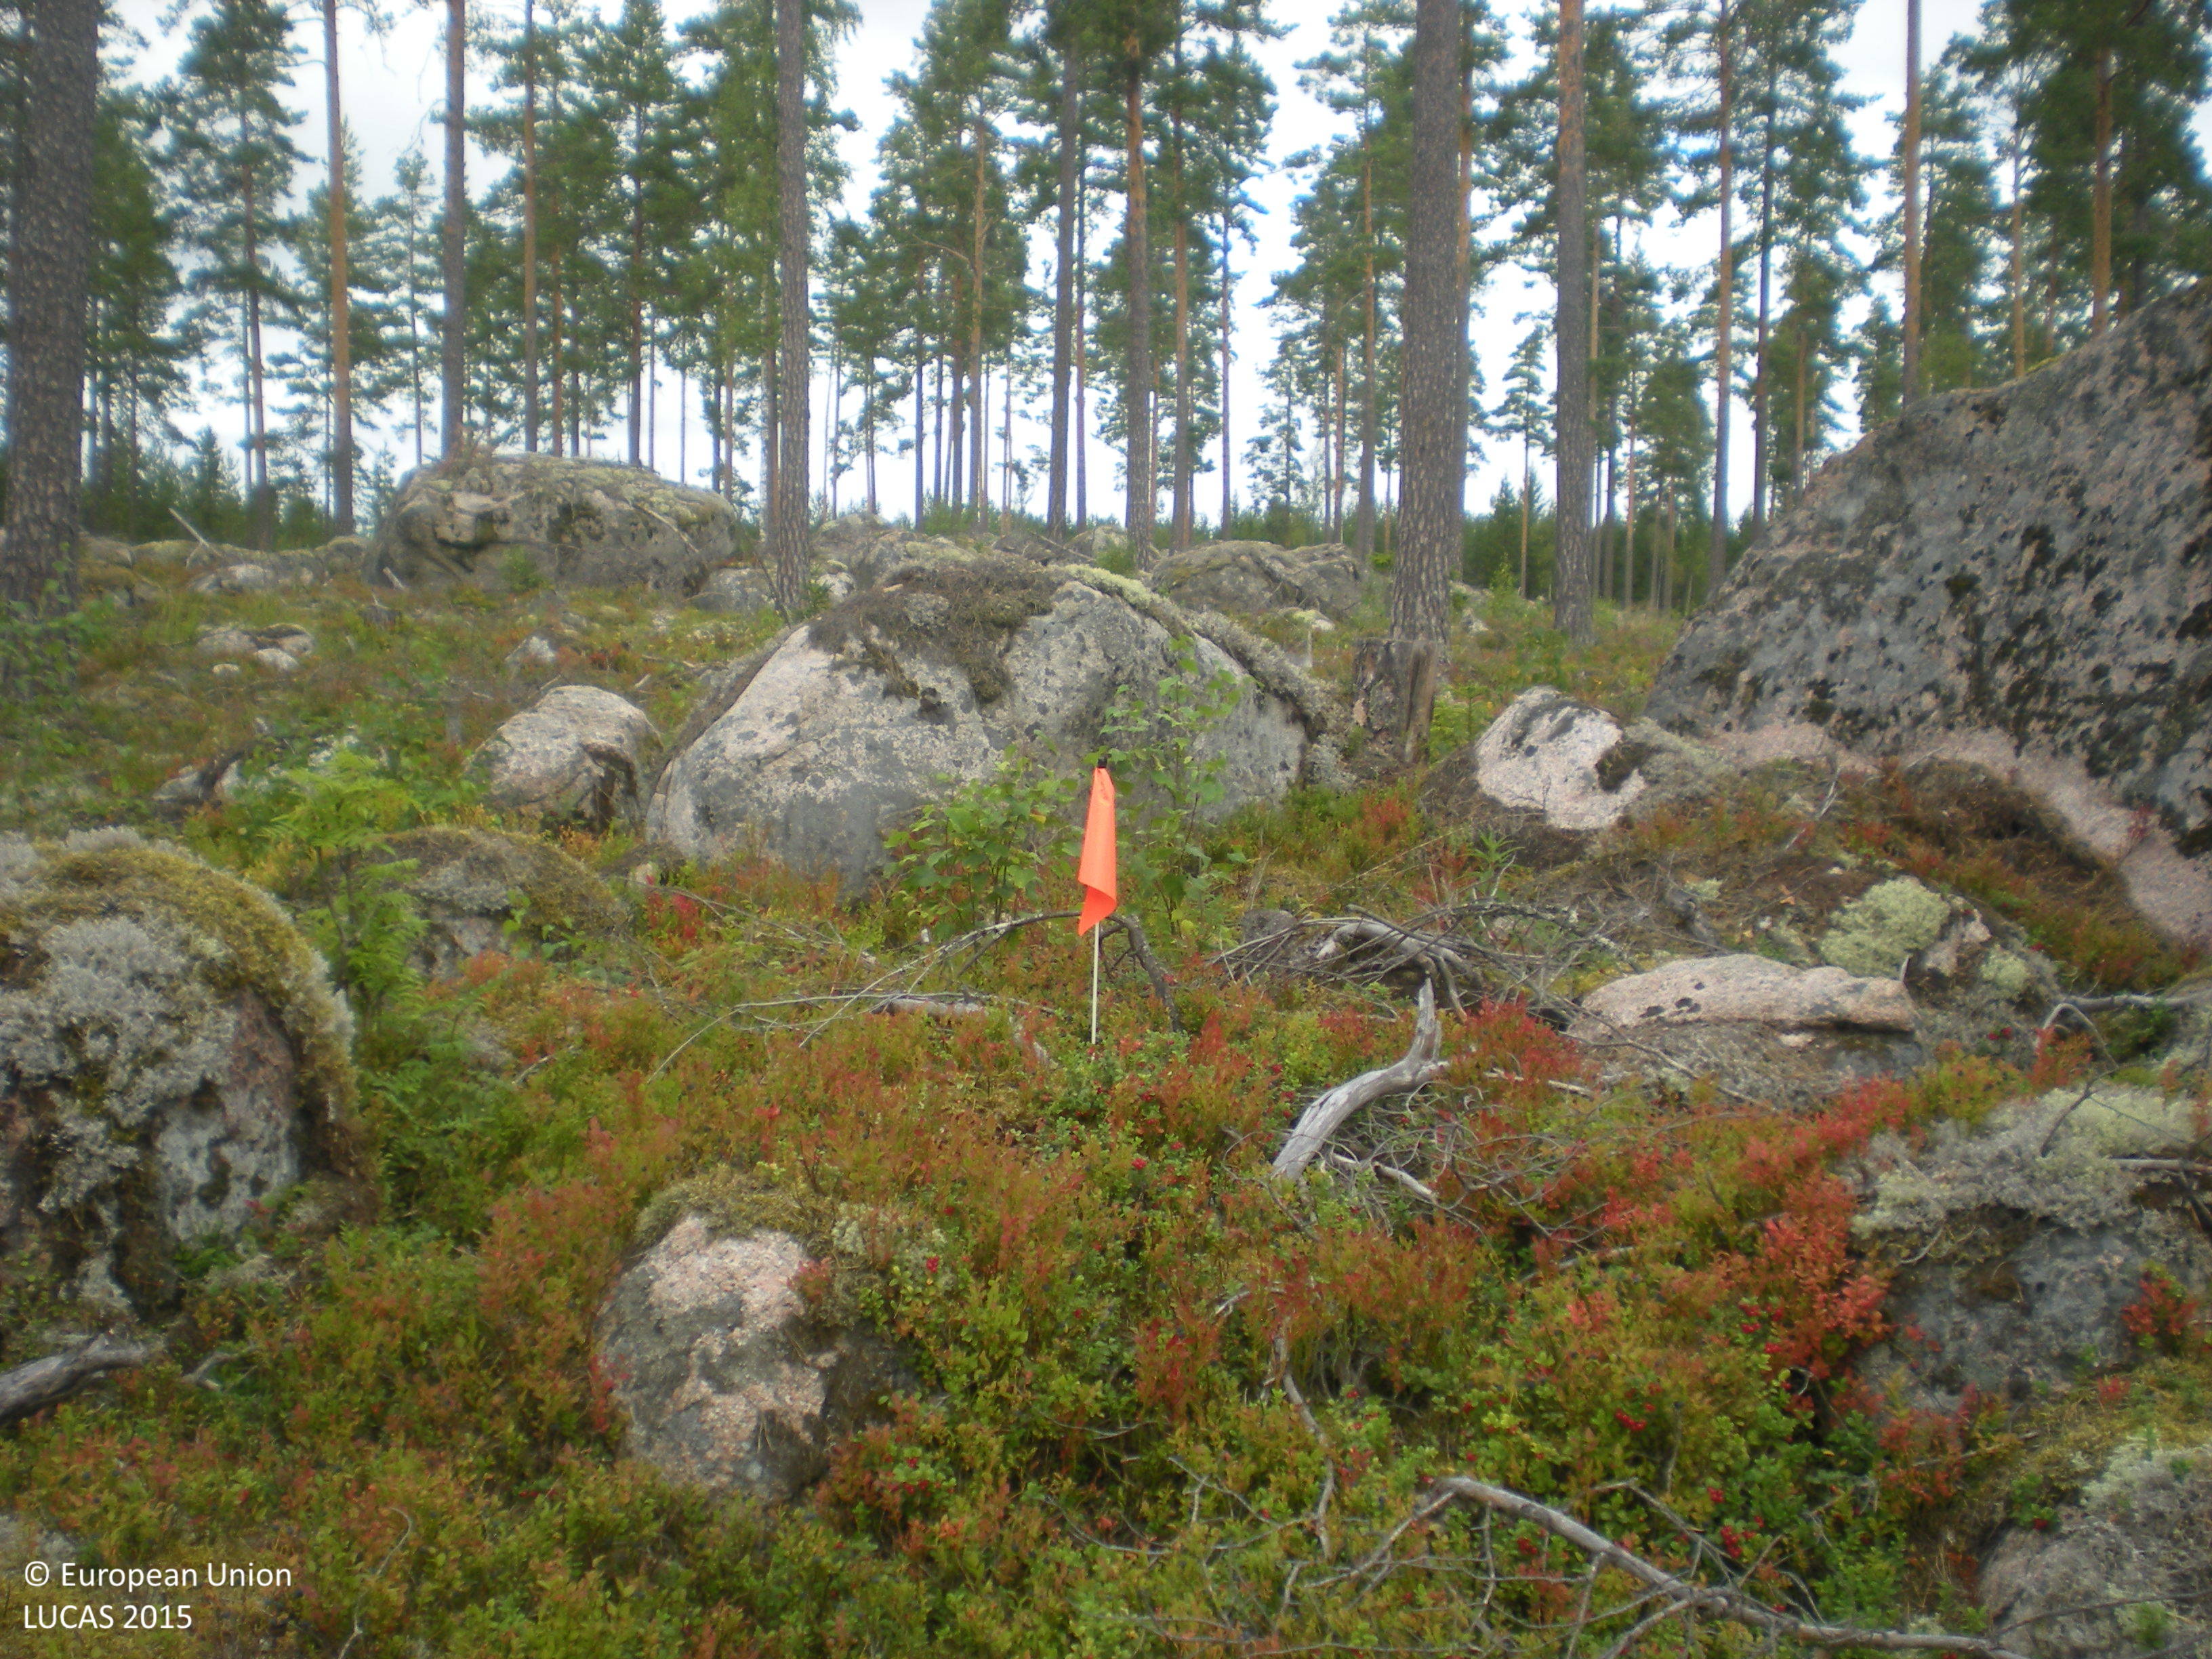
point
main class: Woodland
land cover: Pine dominated coniferous woodland
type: boreal forest
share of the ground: 25 - 50 %
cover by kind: coniferous forest trees 40 %, shrubs 25 %, consolidated bare surface 20 %, lichens and mosses 10 %, broadleaved forest trees 5 %
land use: Forestry
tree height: > 5 m
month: August
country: SE
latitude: 60.4323
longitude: 16.8022
